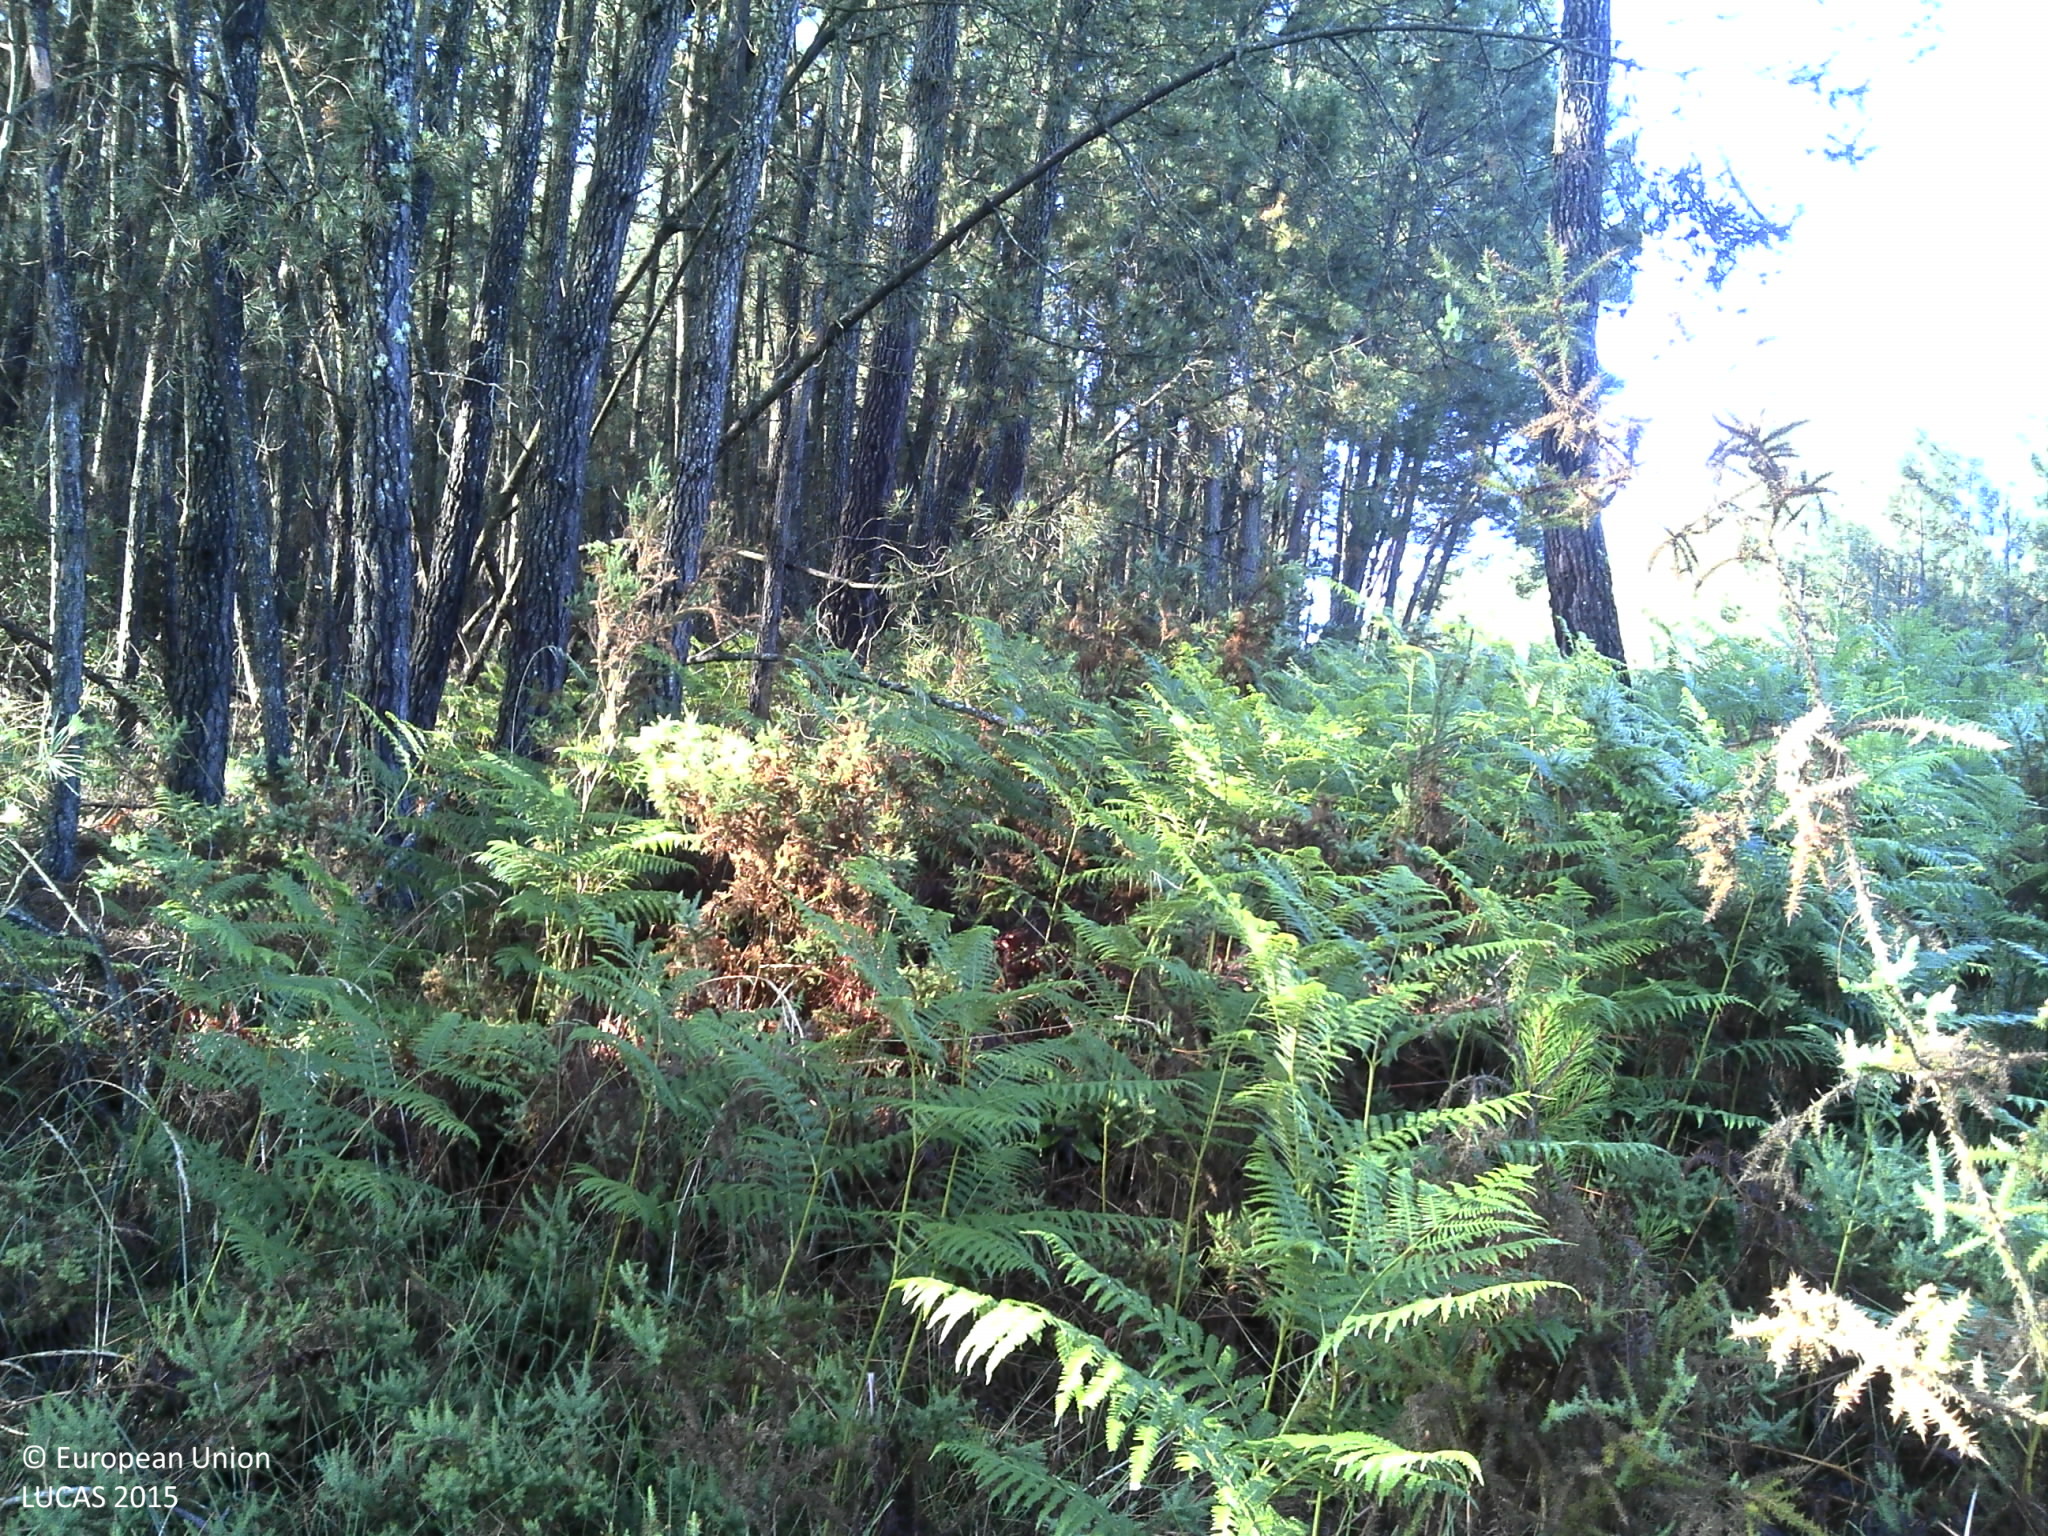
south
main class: Woodland
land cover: Pine dominated coniferous woodland
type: coniferous forest of the mediterranean region
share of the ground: 10 - 25 %
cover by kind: unconsolidated bare surface 45 %, shrubs 35 %, coniferous forest trees 20 %
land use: Forestry
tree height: > 5 m
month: June
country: PT
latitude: 41.2405
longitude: -7.6308
